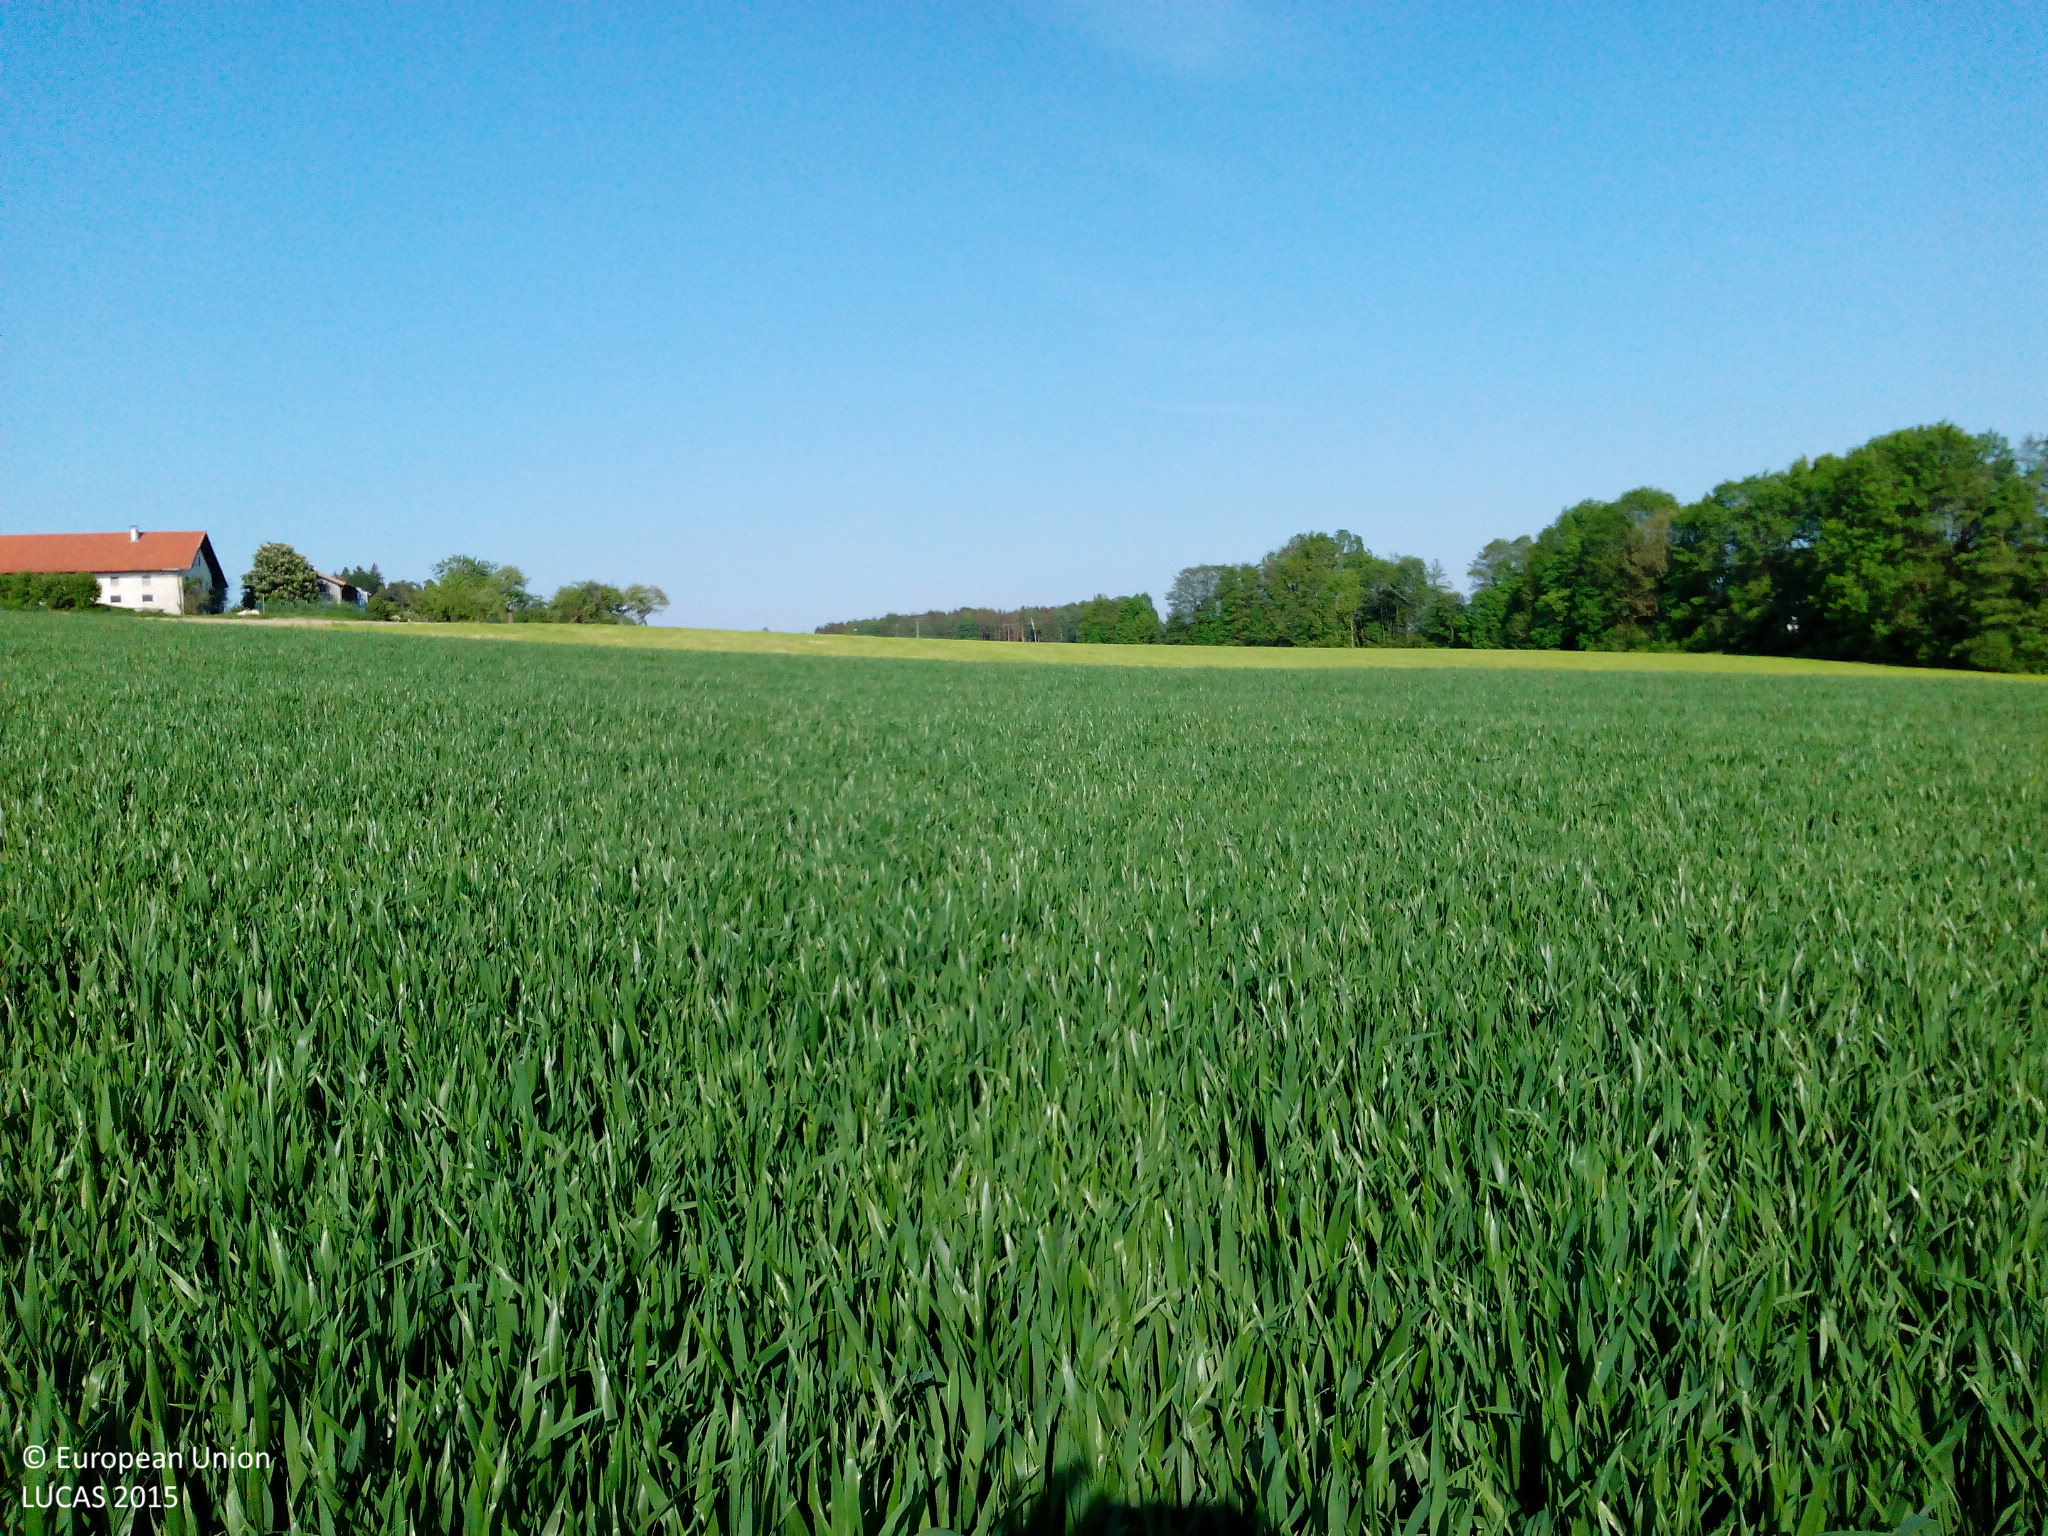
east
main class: Cropland
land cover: Common wheat
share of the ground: > 75 %
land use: Agriculture (excluding fallow land and kitchen gardens)
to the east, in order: Common wheat; Grassland without tree/shrub cover
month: May
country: DE
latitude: 48.2213
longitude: 12.1122
